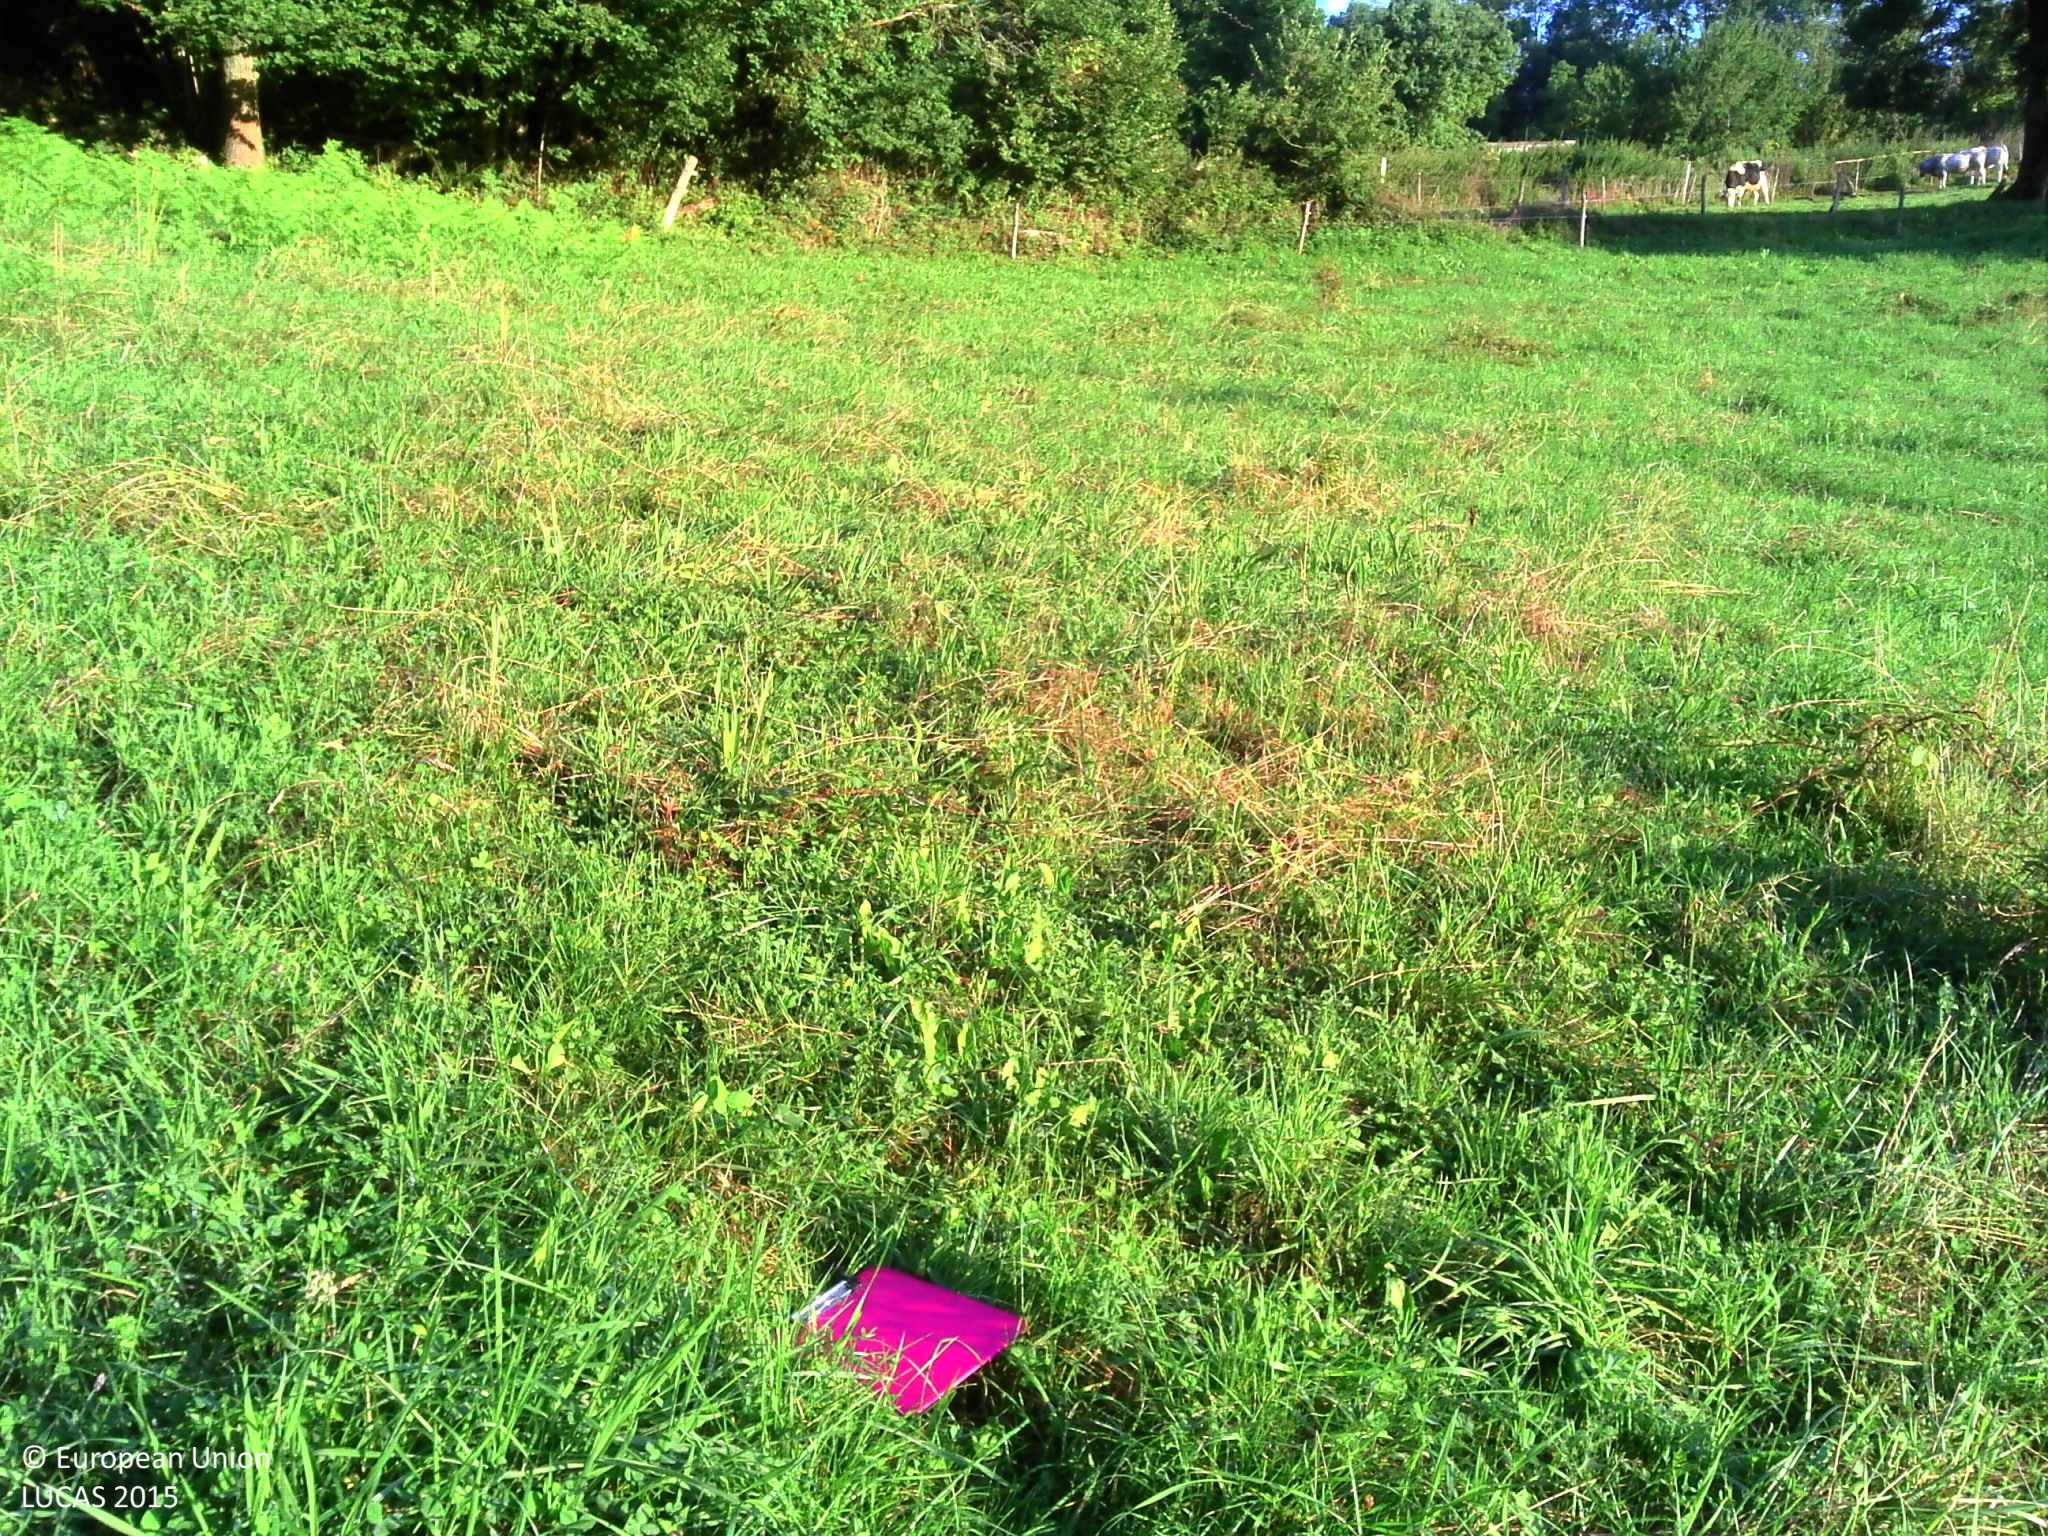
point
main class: Grassland
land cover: Grassland without tree/shrub cover
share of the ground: > 75 %
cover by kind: herbaceous plants 100 %
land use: Agriculture (excluding fallow land and kitchen gardens)
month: August
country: FR
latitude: 42.9823
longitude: 1.4587
